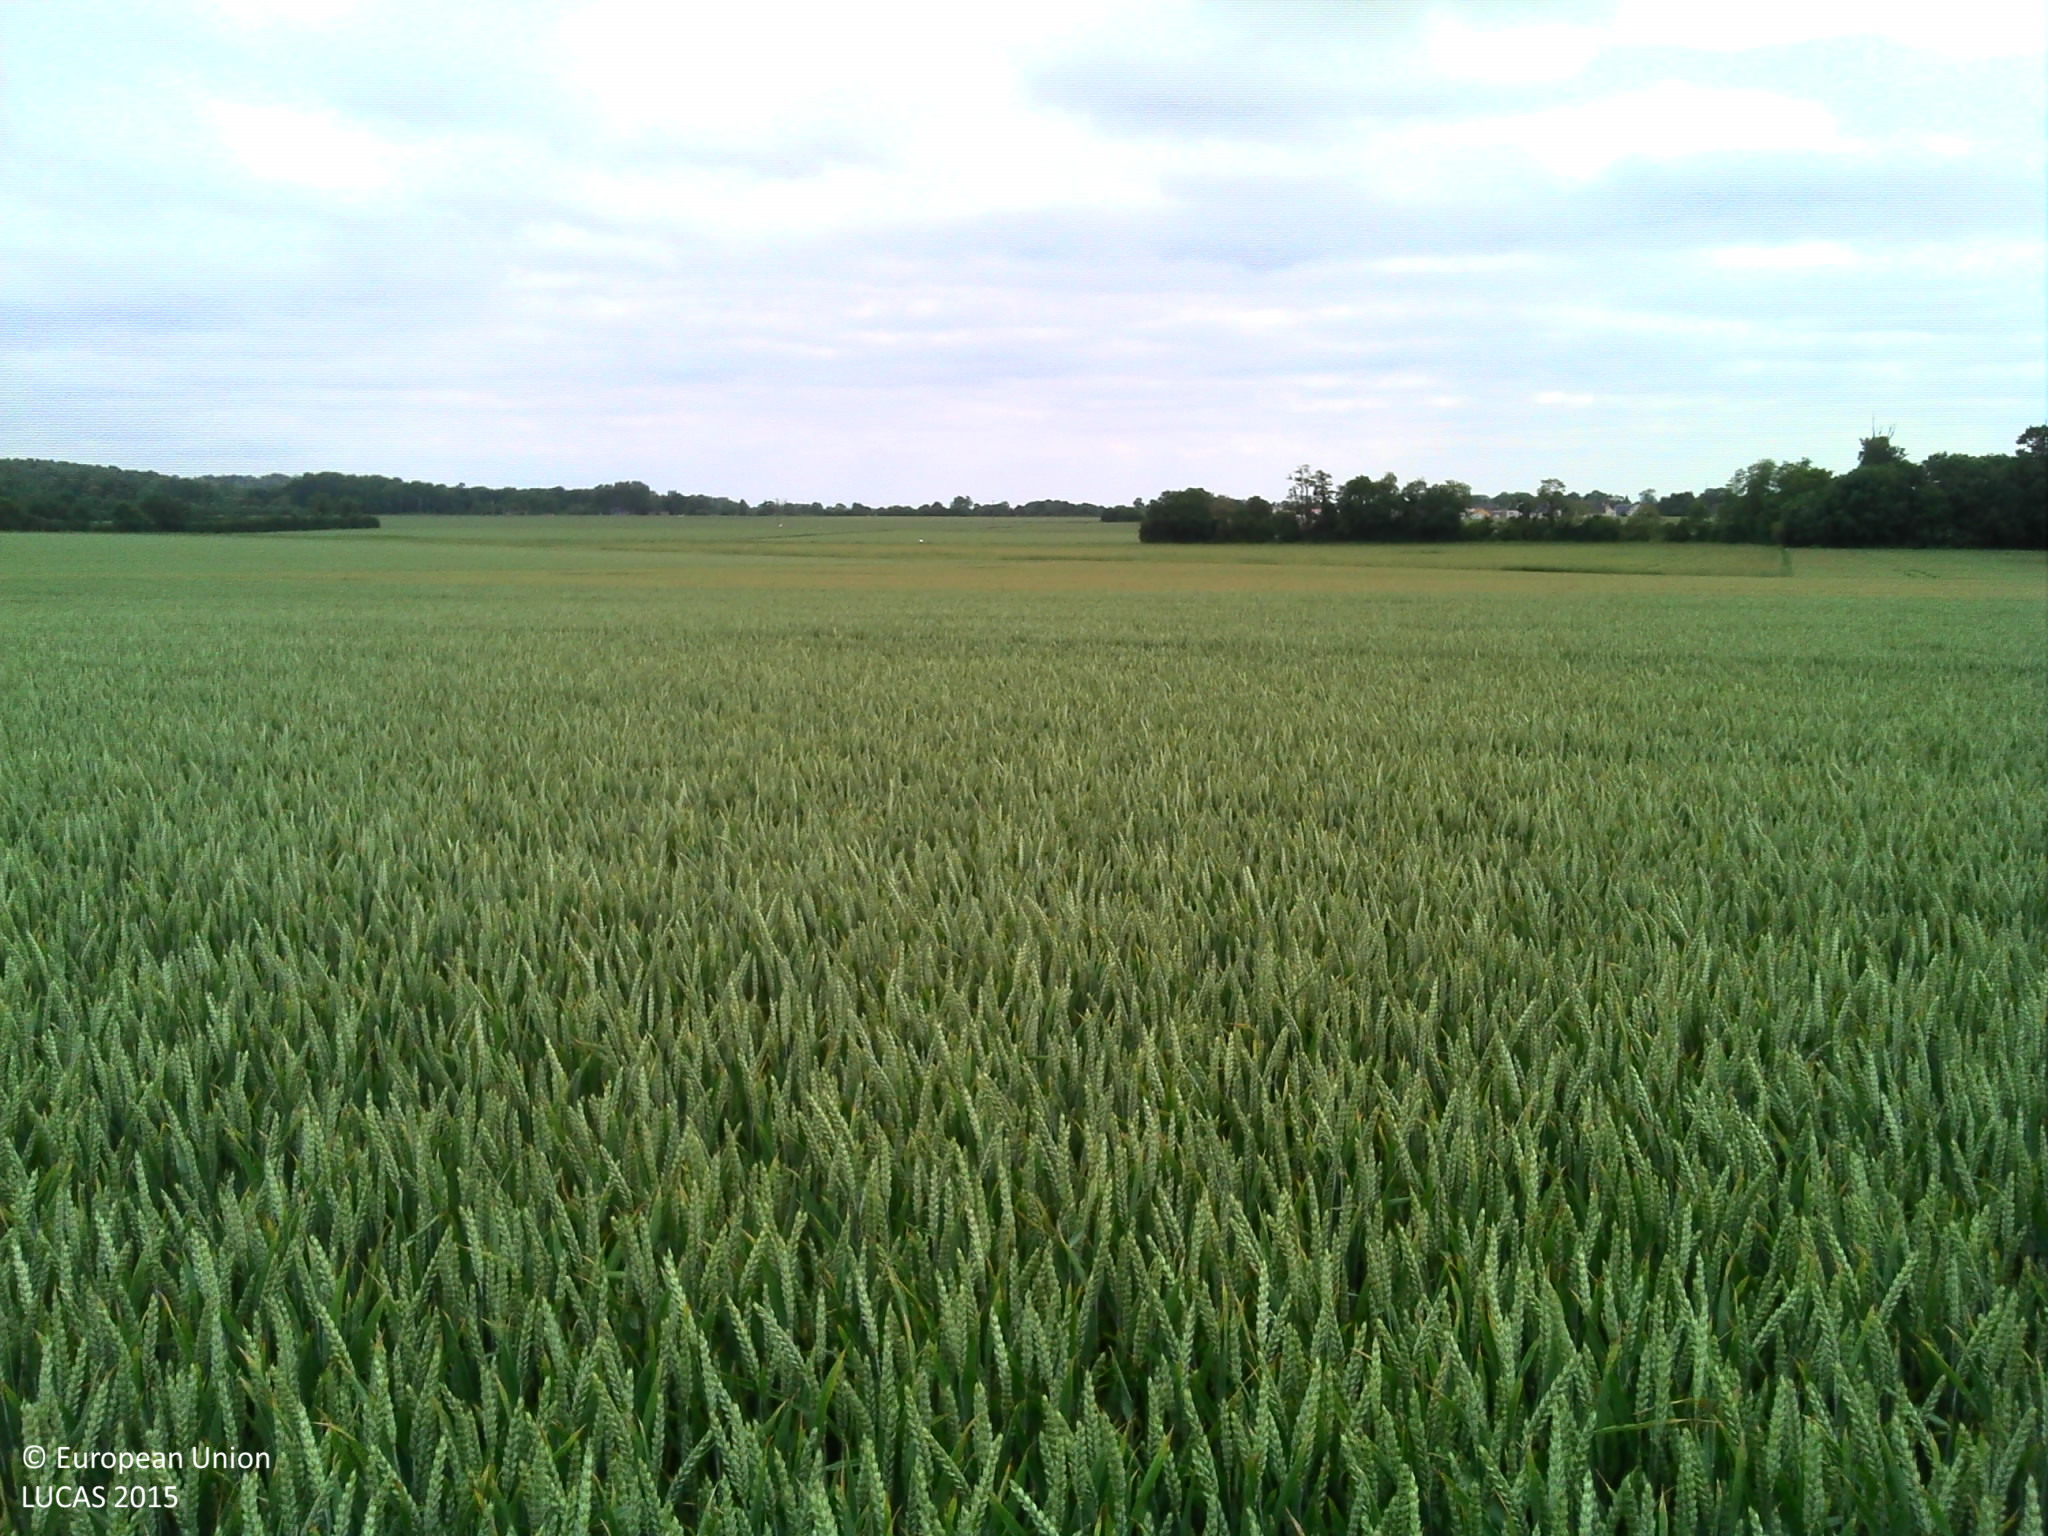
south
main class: Cropland
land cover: Common wheat
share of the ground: > 75 %
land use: Agriculture (excluding fallow land and kitchen gardens)
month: June
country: FR
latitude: 49.2327
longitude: -0.2373
